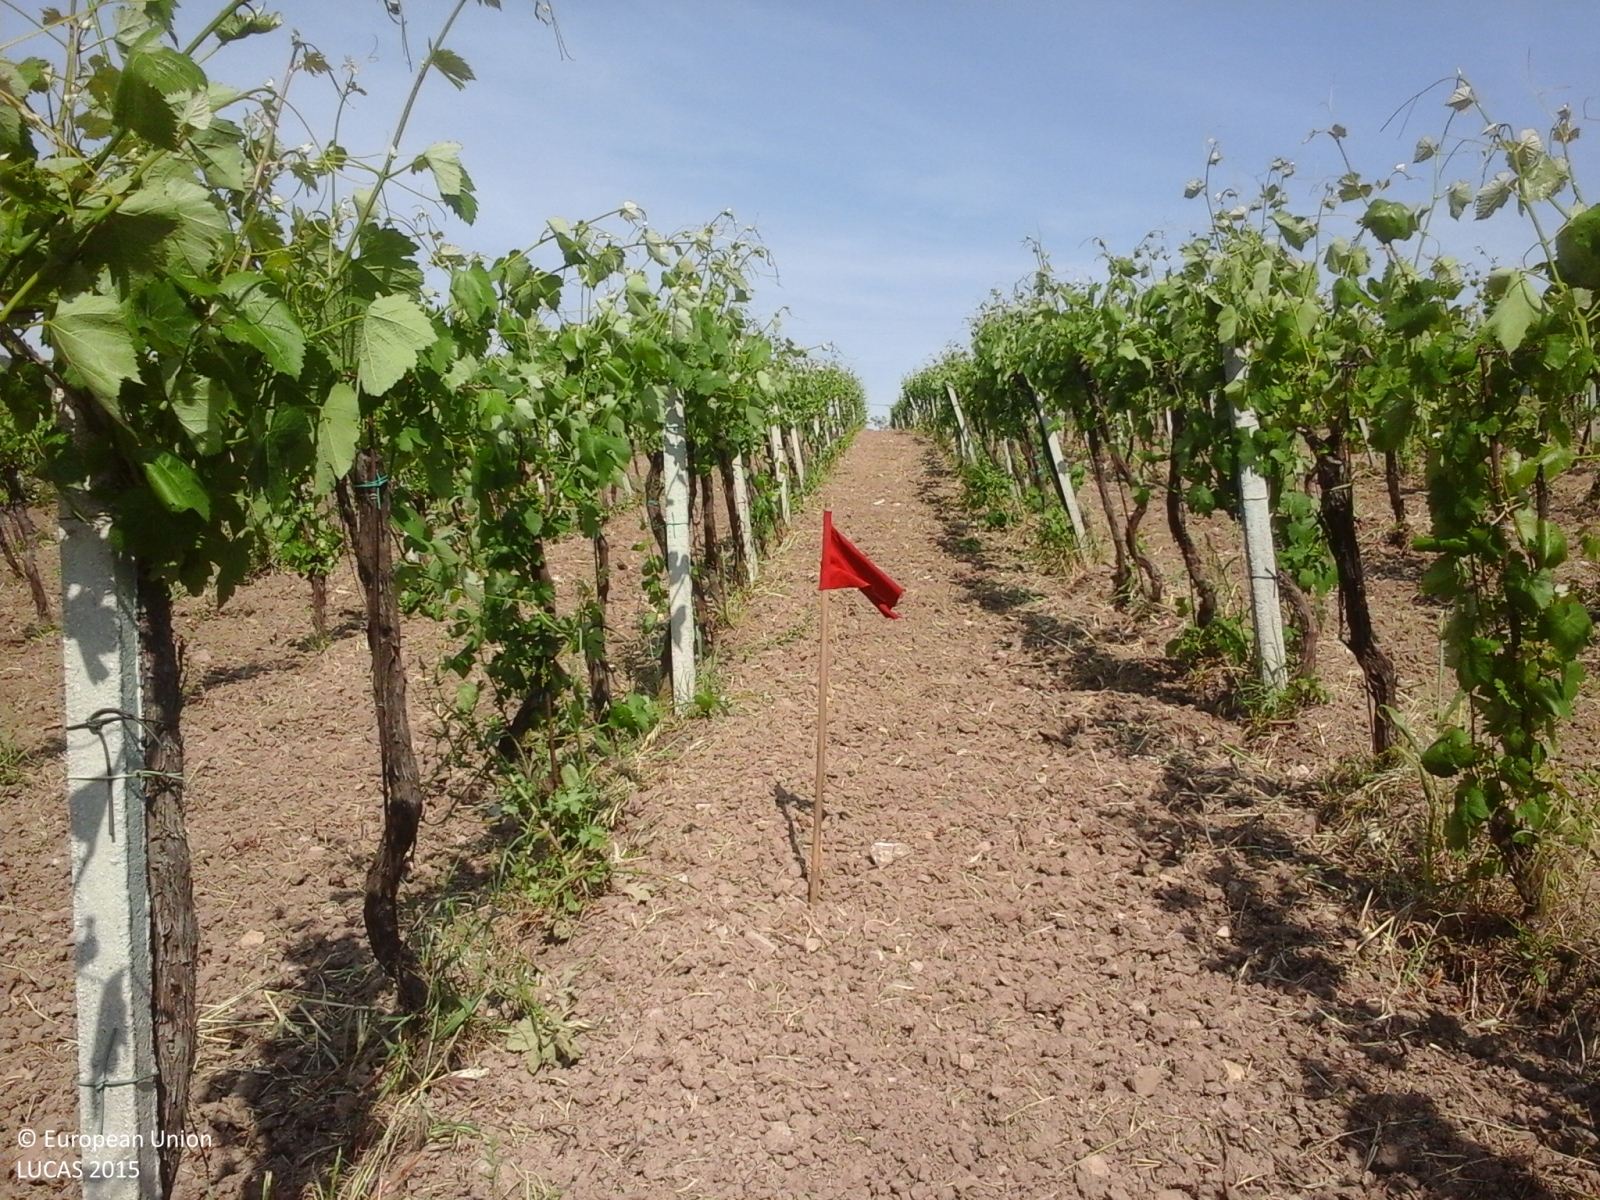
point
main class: Cropland
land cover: Vineyards
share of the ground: 50 - 75 %
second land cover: Other bare soil
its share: > 75 %
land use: Agriculture (excluding fallow land and kitchen gardens)
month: May
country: IT
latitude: 41.2240
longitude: 14.6944
